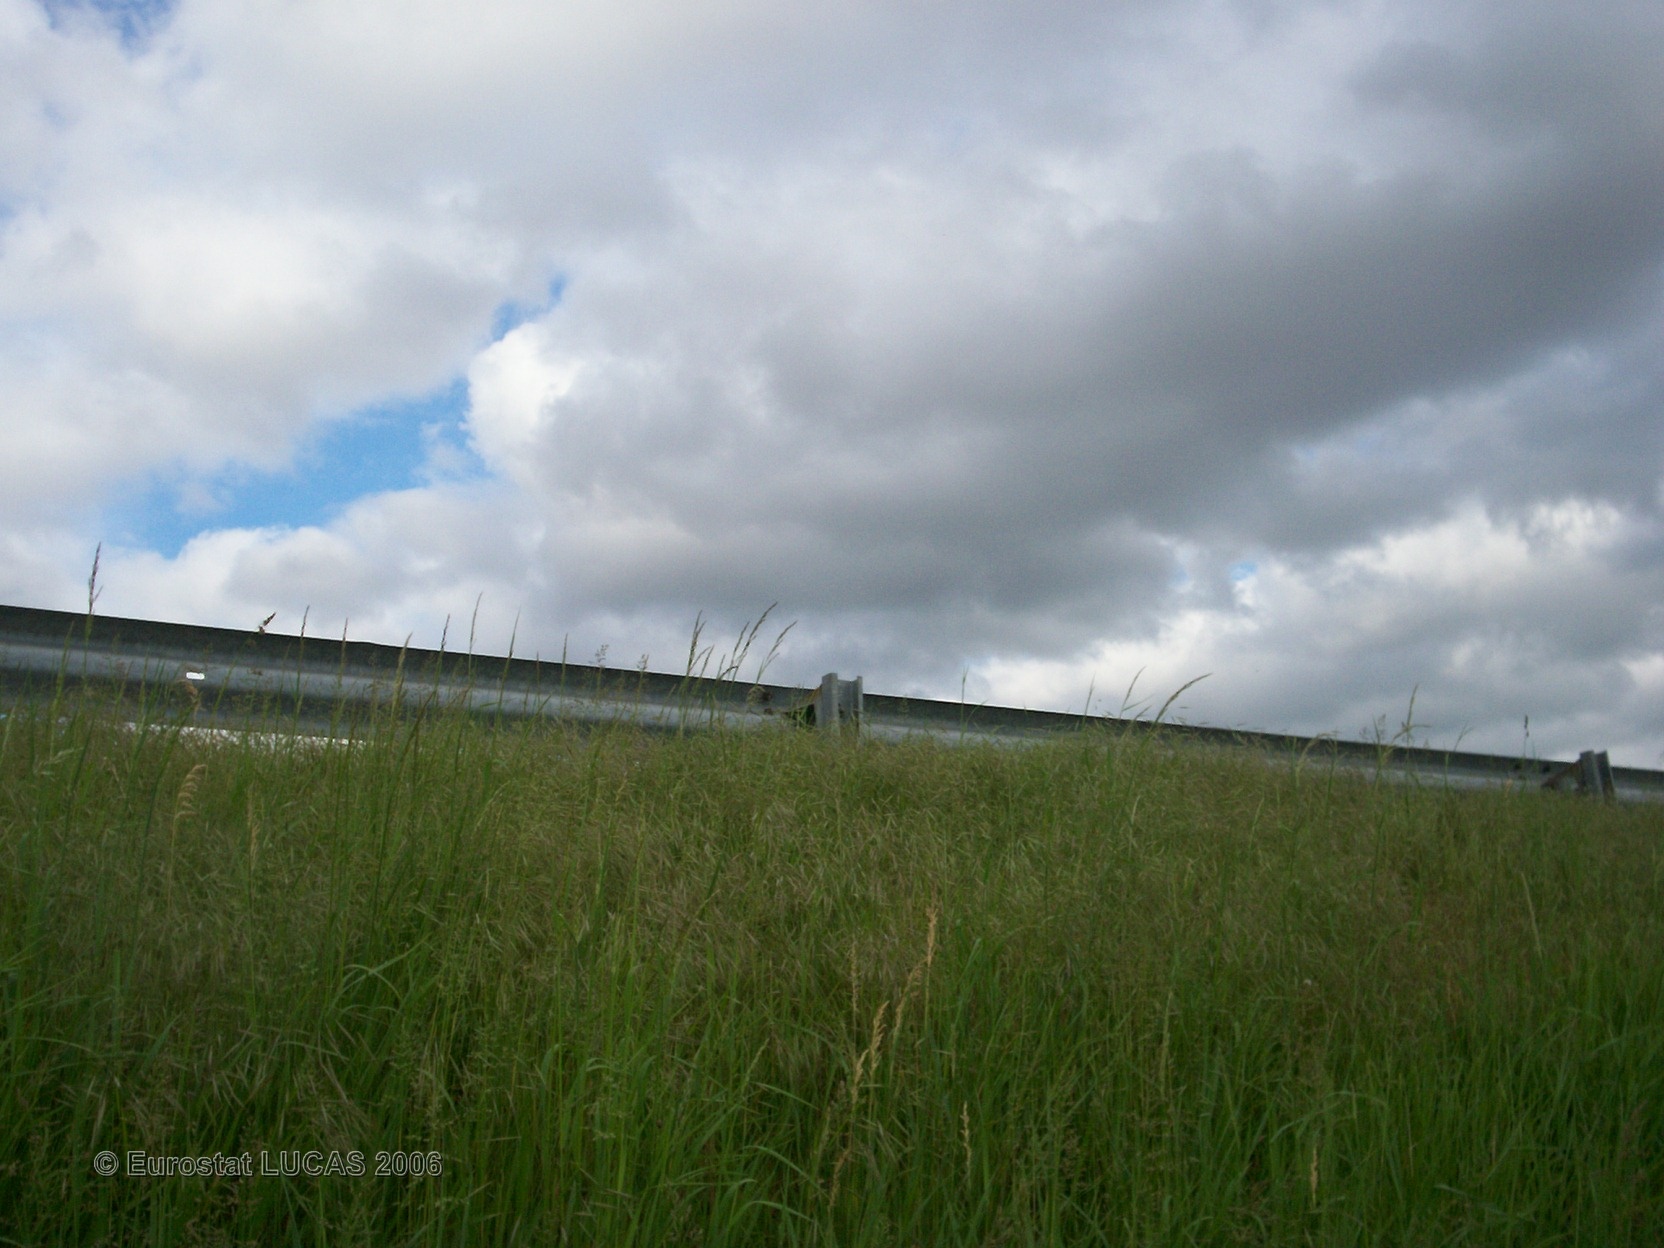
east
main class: Grassland
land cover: Grassland without tree/shrub cover
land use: Unused
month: May
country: FR
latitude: 45.9324
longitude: 4.7282
